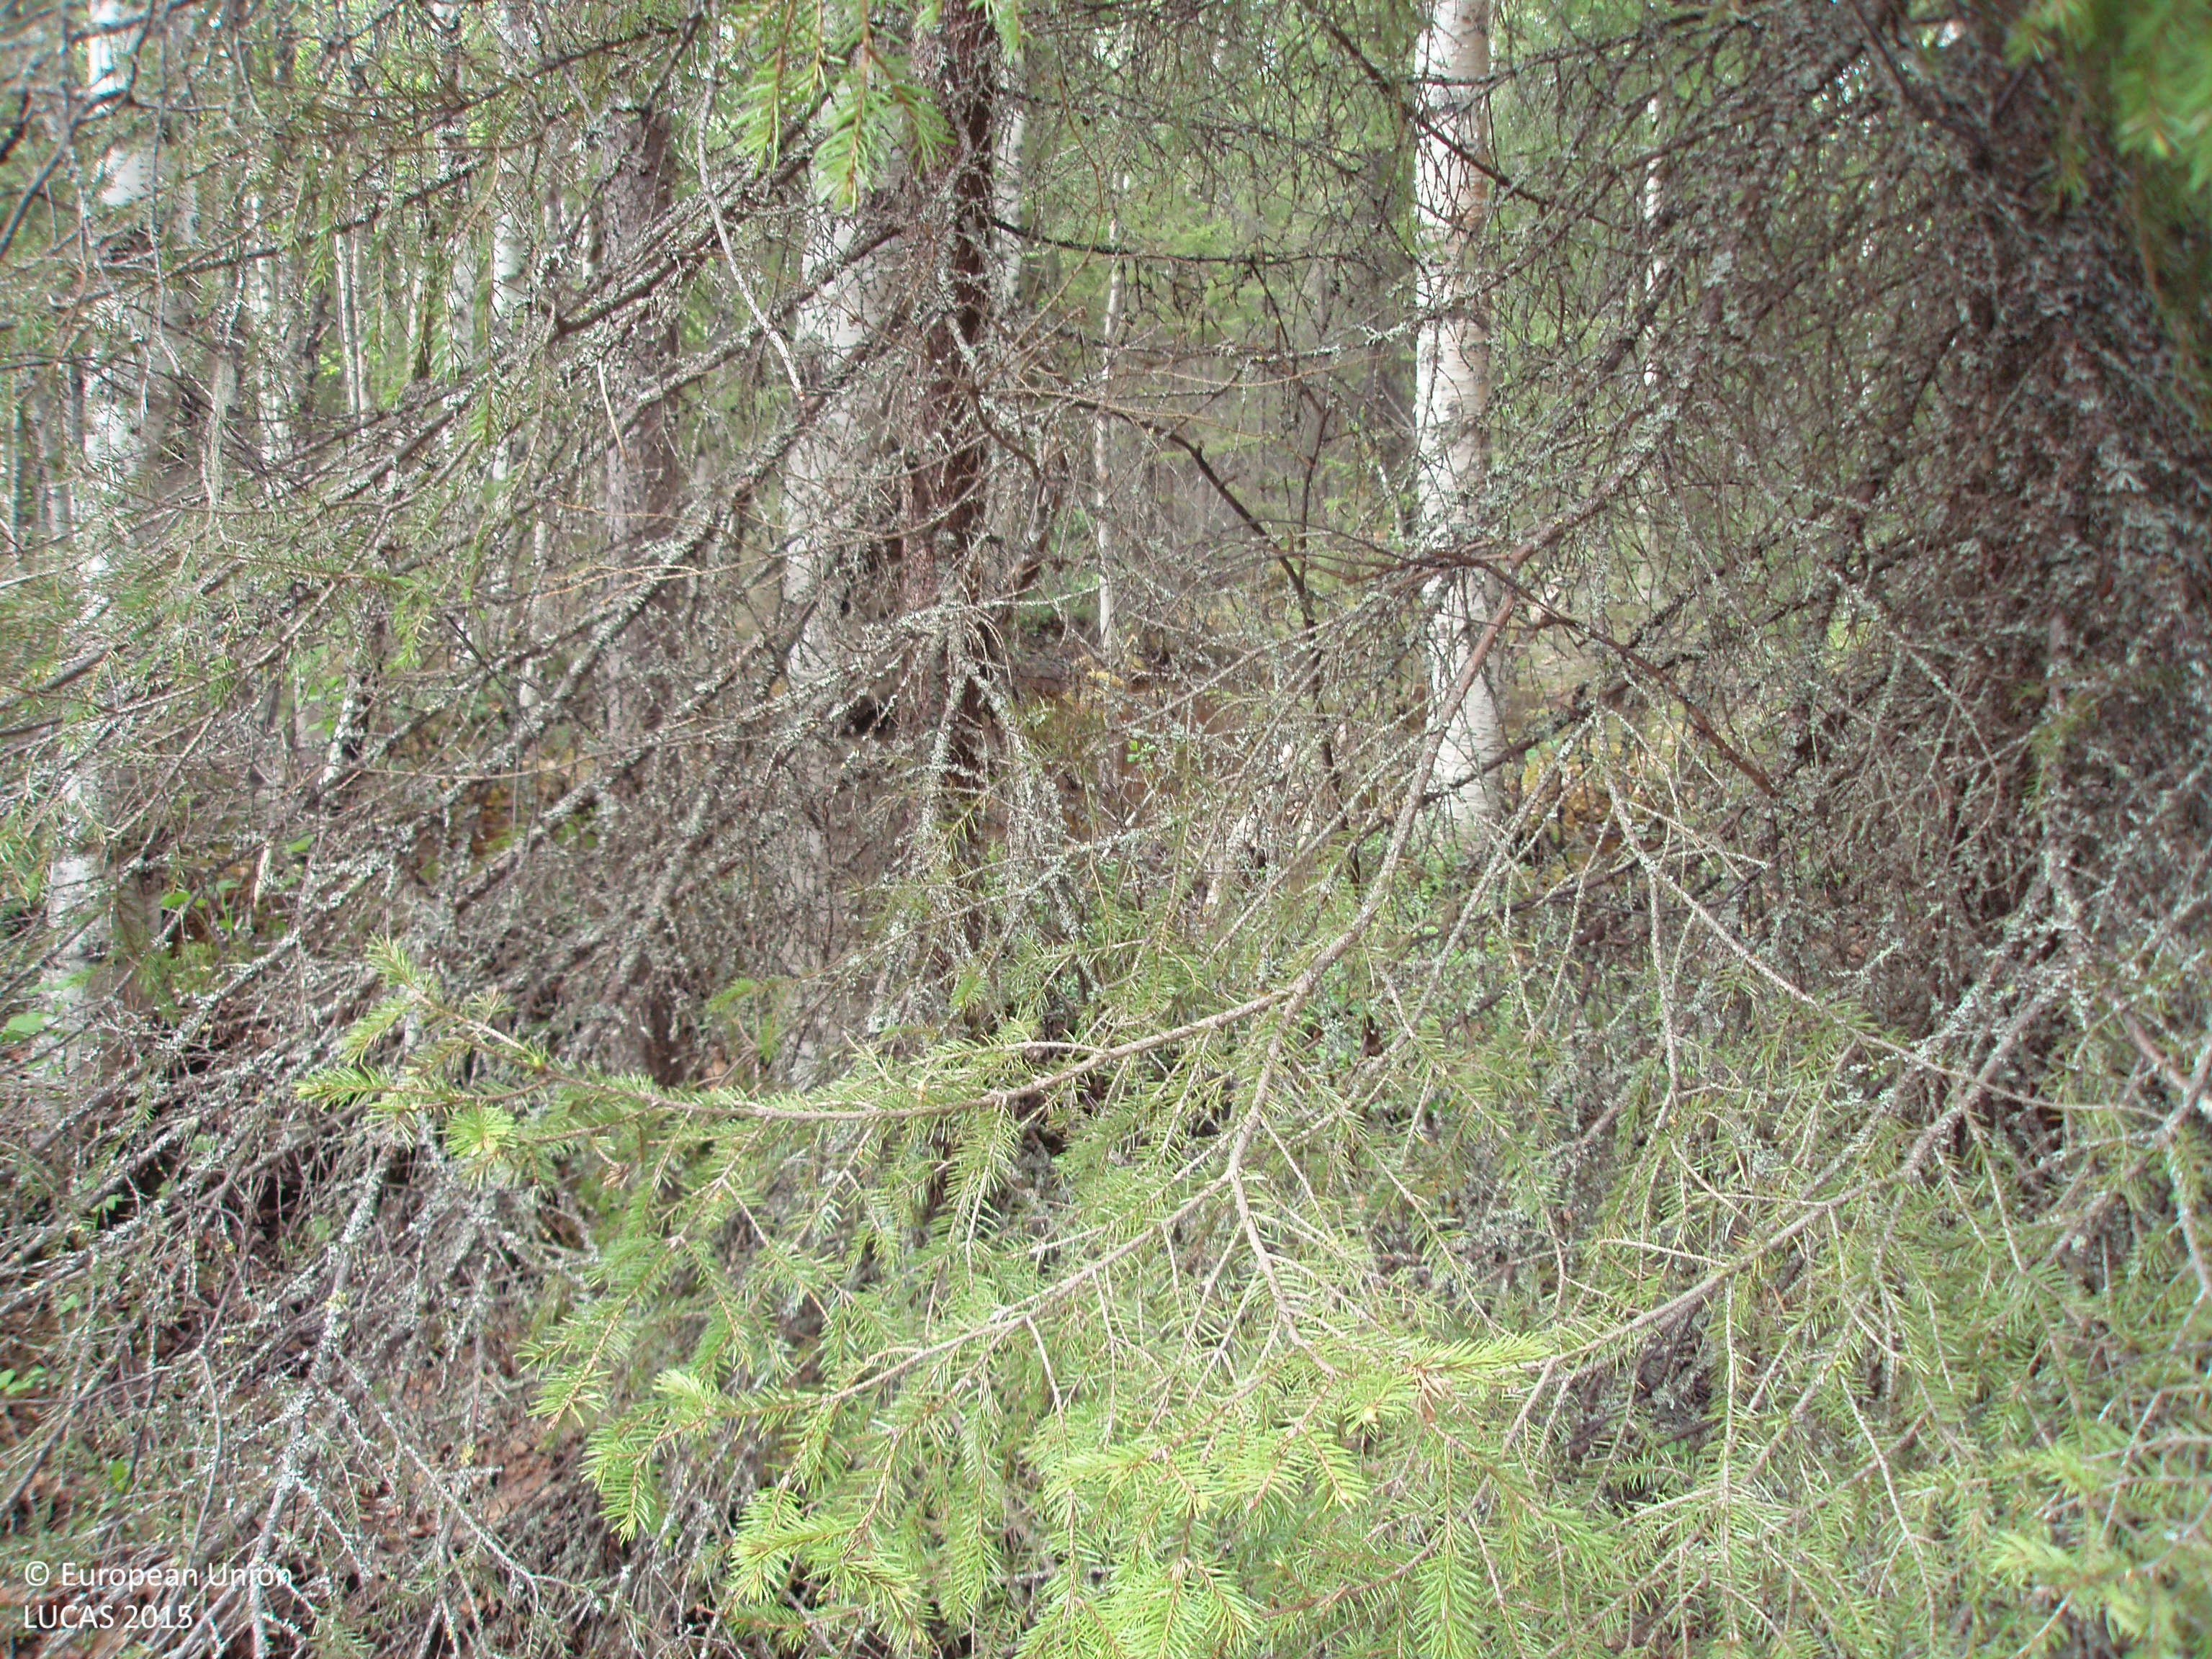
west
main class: Woodland
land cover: Other mixed woodland
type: boreal forest
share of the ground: > 75 %
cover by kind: coniferous forest trees 40 %, broadleaved forest trees 40 %, shrubs 10 %, herbaceous plants 10 %
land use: Forestry
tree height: > 5 m
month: June
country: FI
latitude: 67.1809
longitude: 26.9320
